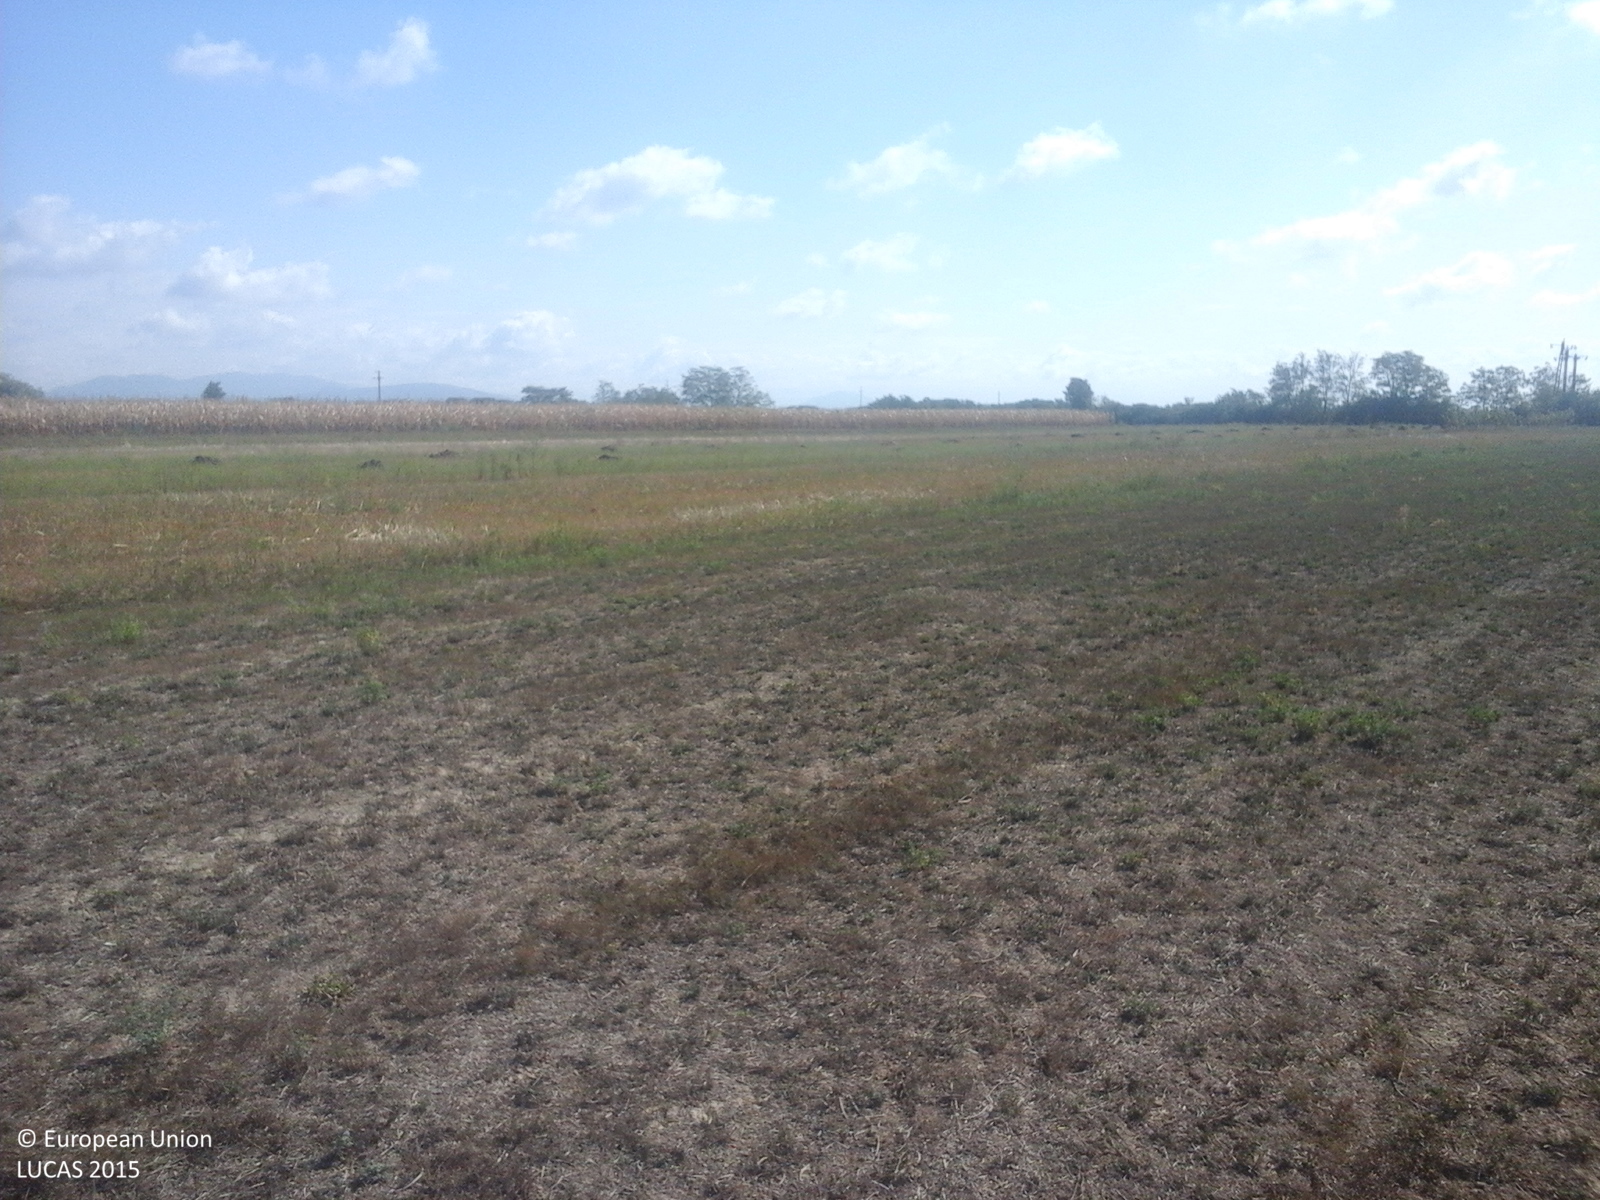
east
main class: Cropland
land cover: Lucerne
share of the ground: > 75 %
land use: Agriculture (excluding fallow land and kitchen gardens)
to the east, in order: Lucerne; Common wheat; Grassland without tree/shrub cover; Common wheat; Lucerne; Maize; Potatoes; Lucerne; Maize; Apple fruit; Common wheat
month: September
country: RO
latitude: 47.9112
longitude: 22.9511
